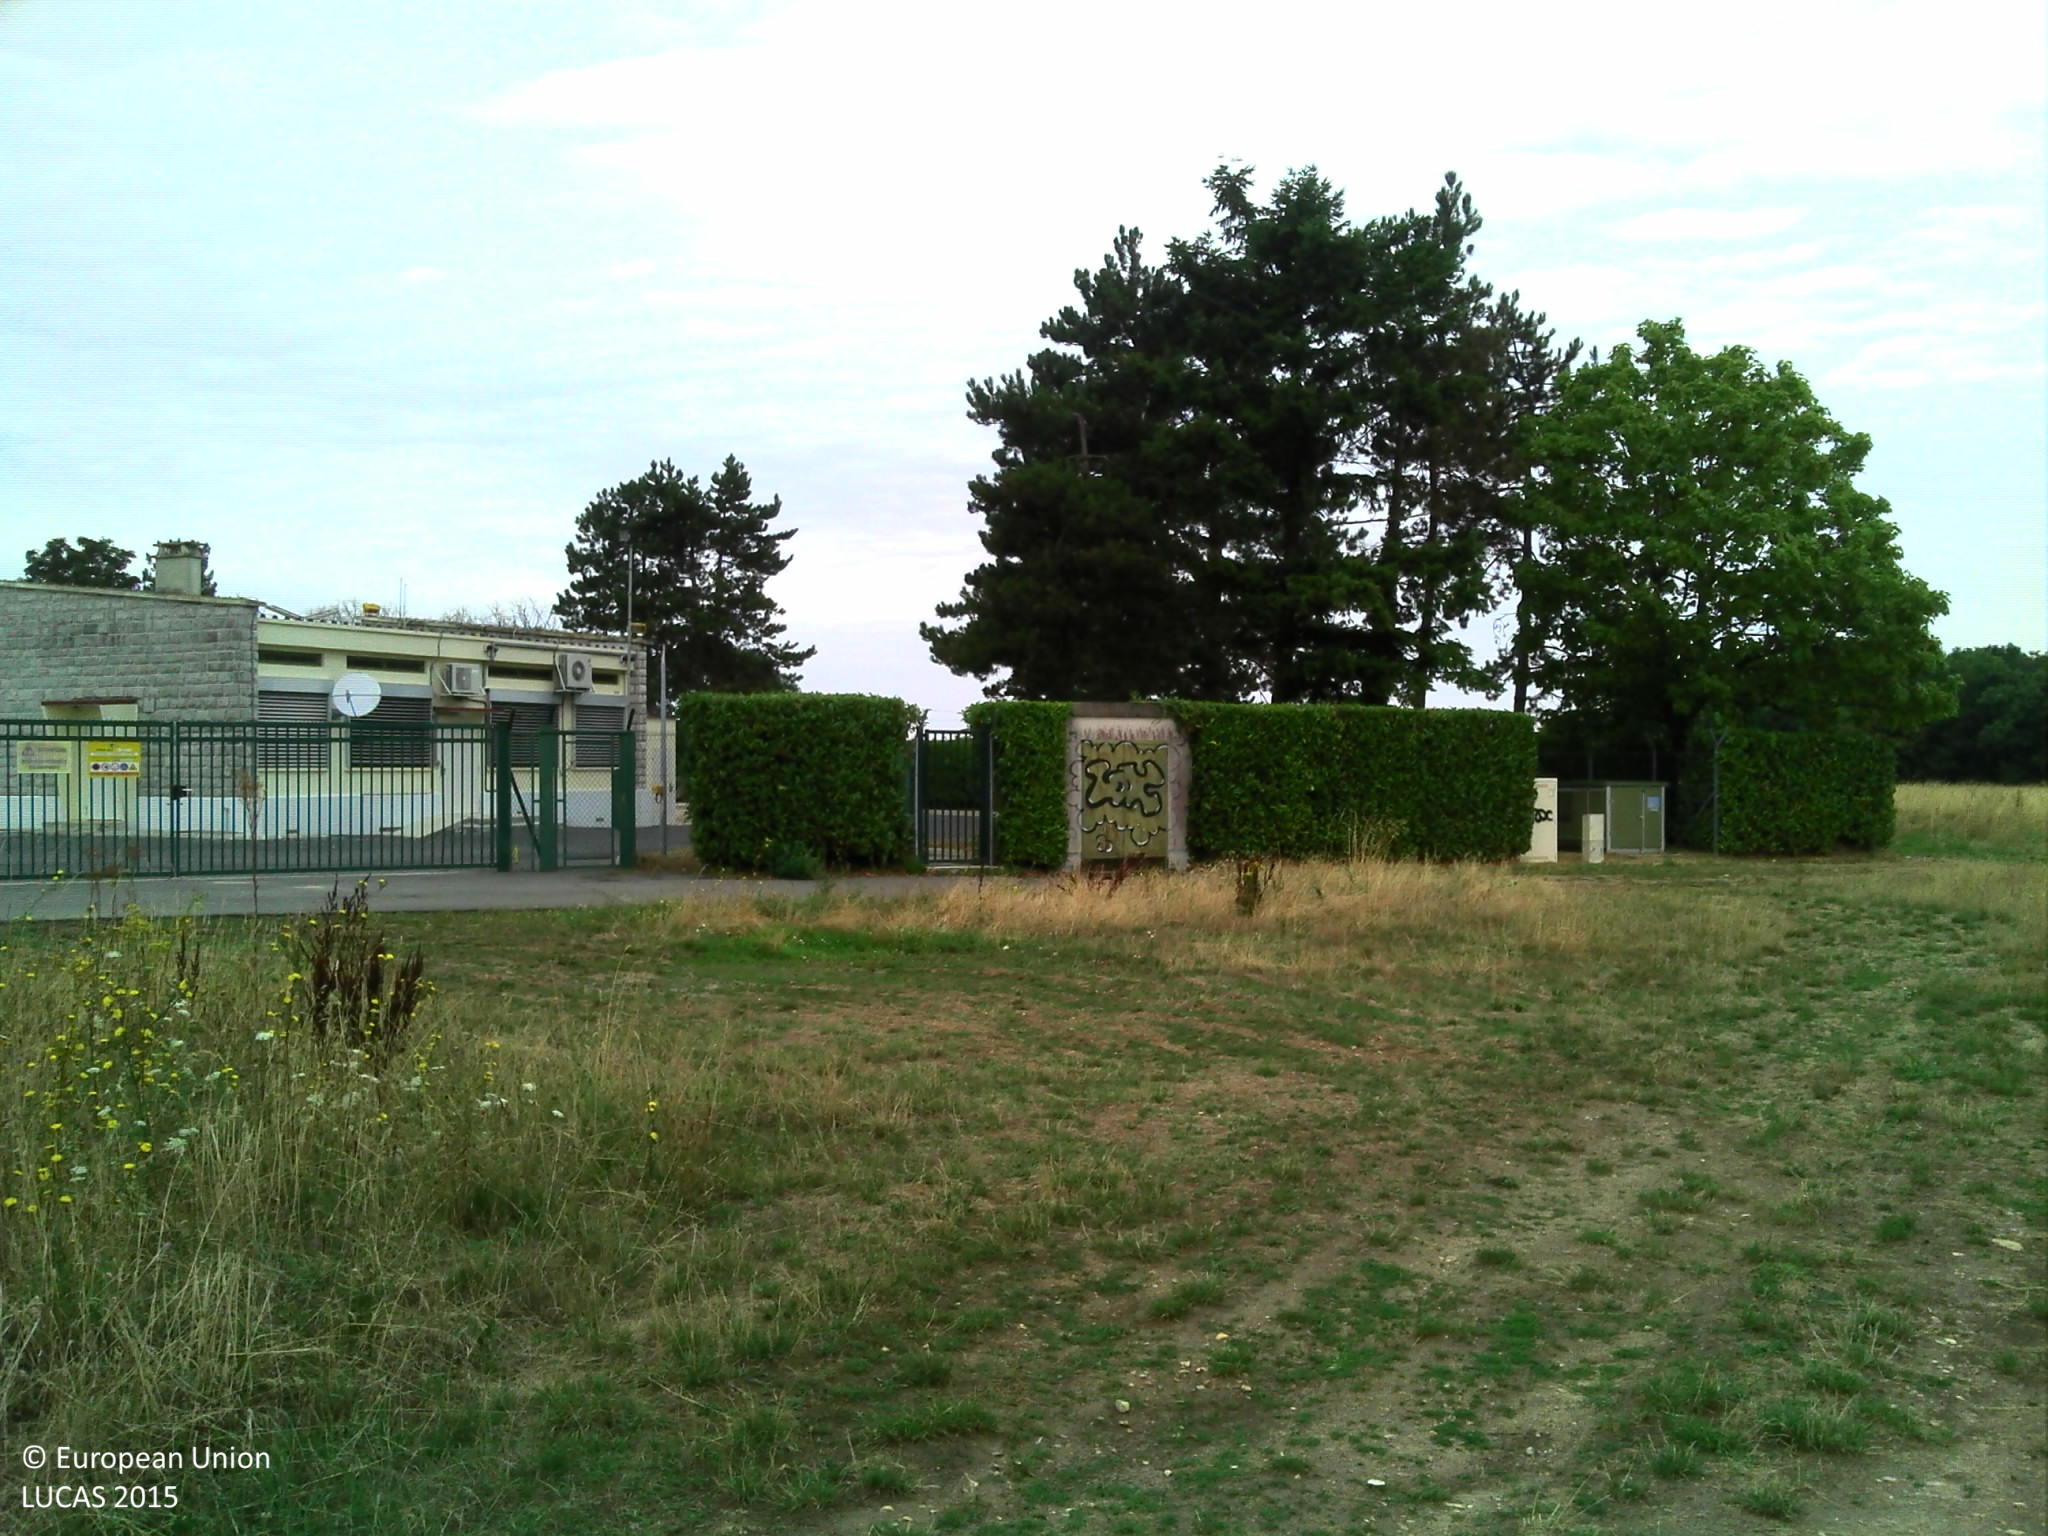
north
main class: Grassland
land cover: Grassland with sparse tree/shrub cover
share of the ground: > 75 %
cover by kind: herbaceous plants 95 %, broadleaved forest trees 5 %
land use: Semi-natural and natural areas not in use
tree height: < 5 m
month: August
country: FR
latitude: 48.1471
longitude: 2.7468
